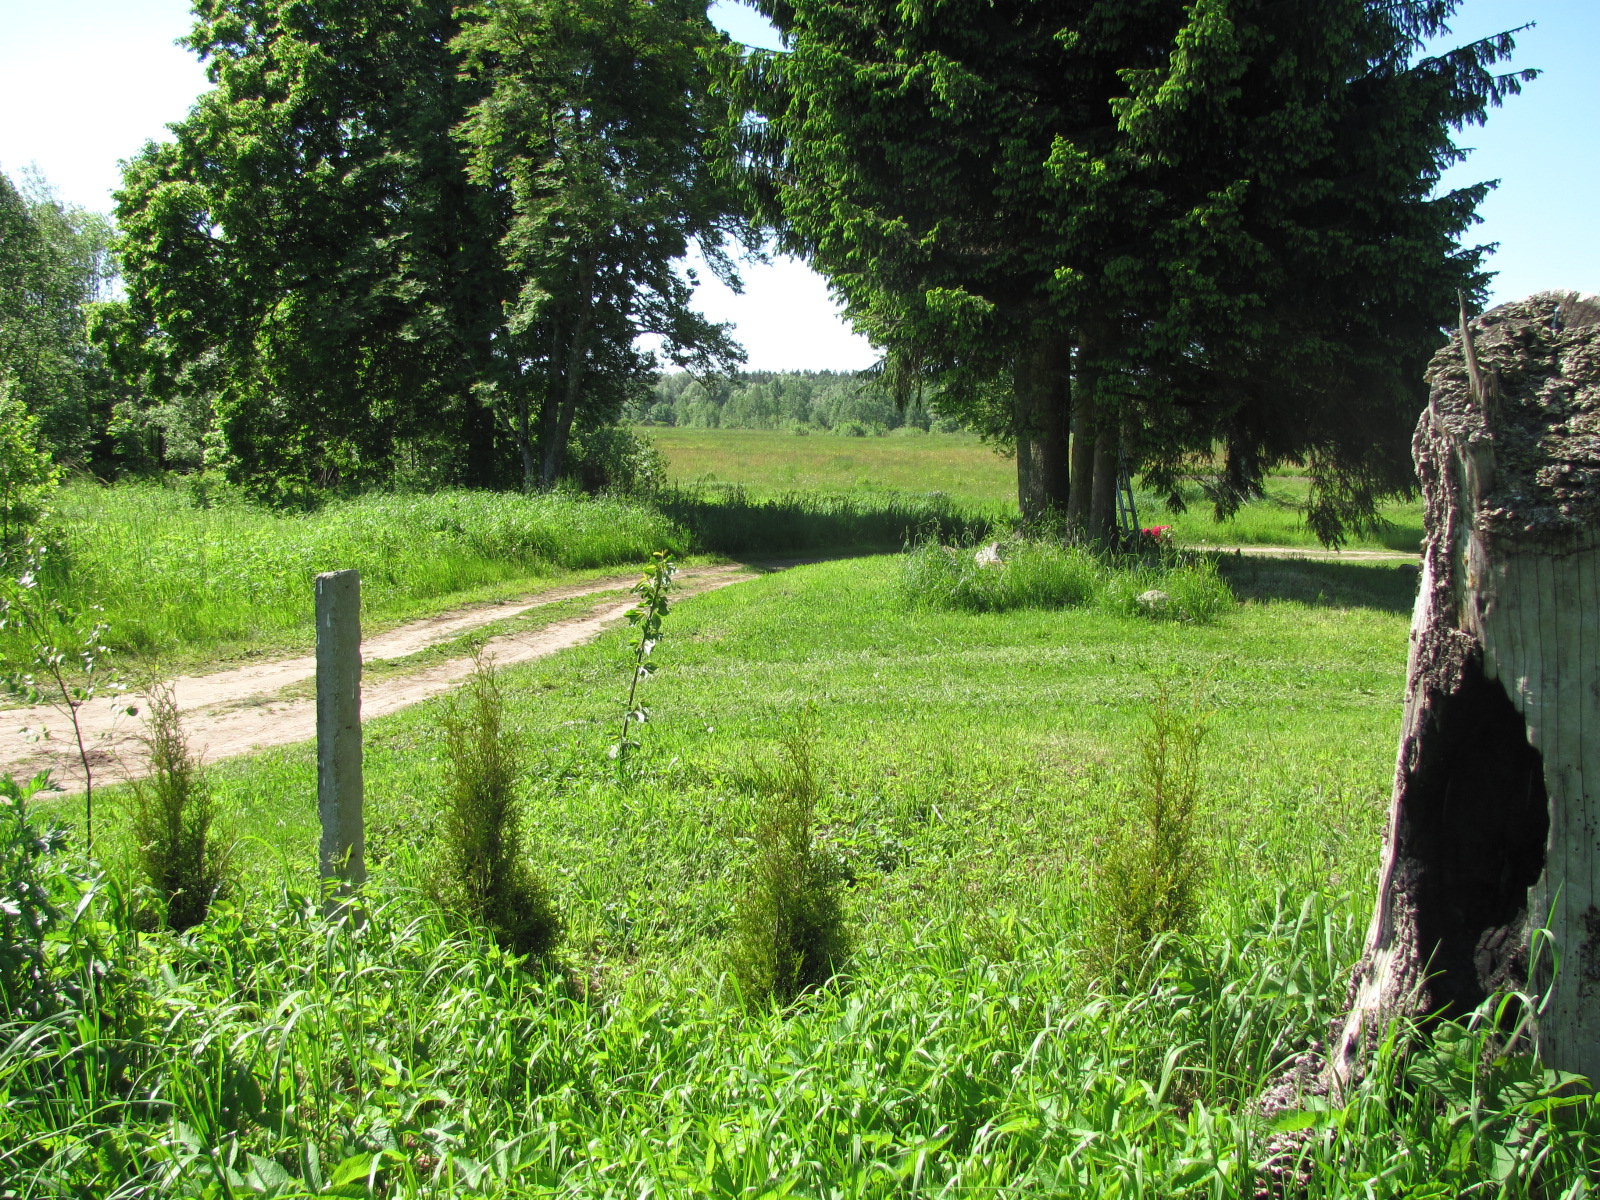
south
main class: Grassland
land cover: Grassland without tree/shrub cover
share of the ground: > 75 %
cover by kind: herbaceous plants 100 %
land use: Residential
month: June
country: LV
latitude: 56.5493
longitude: 24.3250
